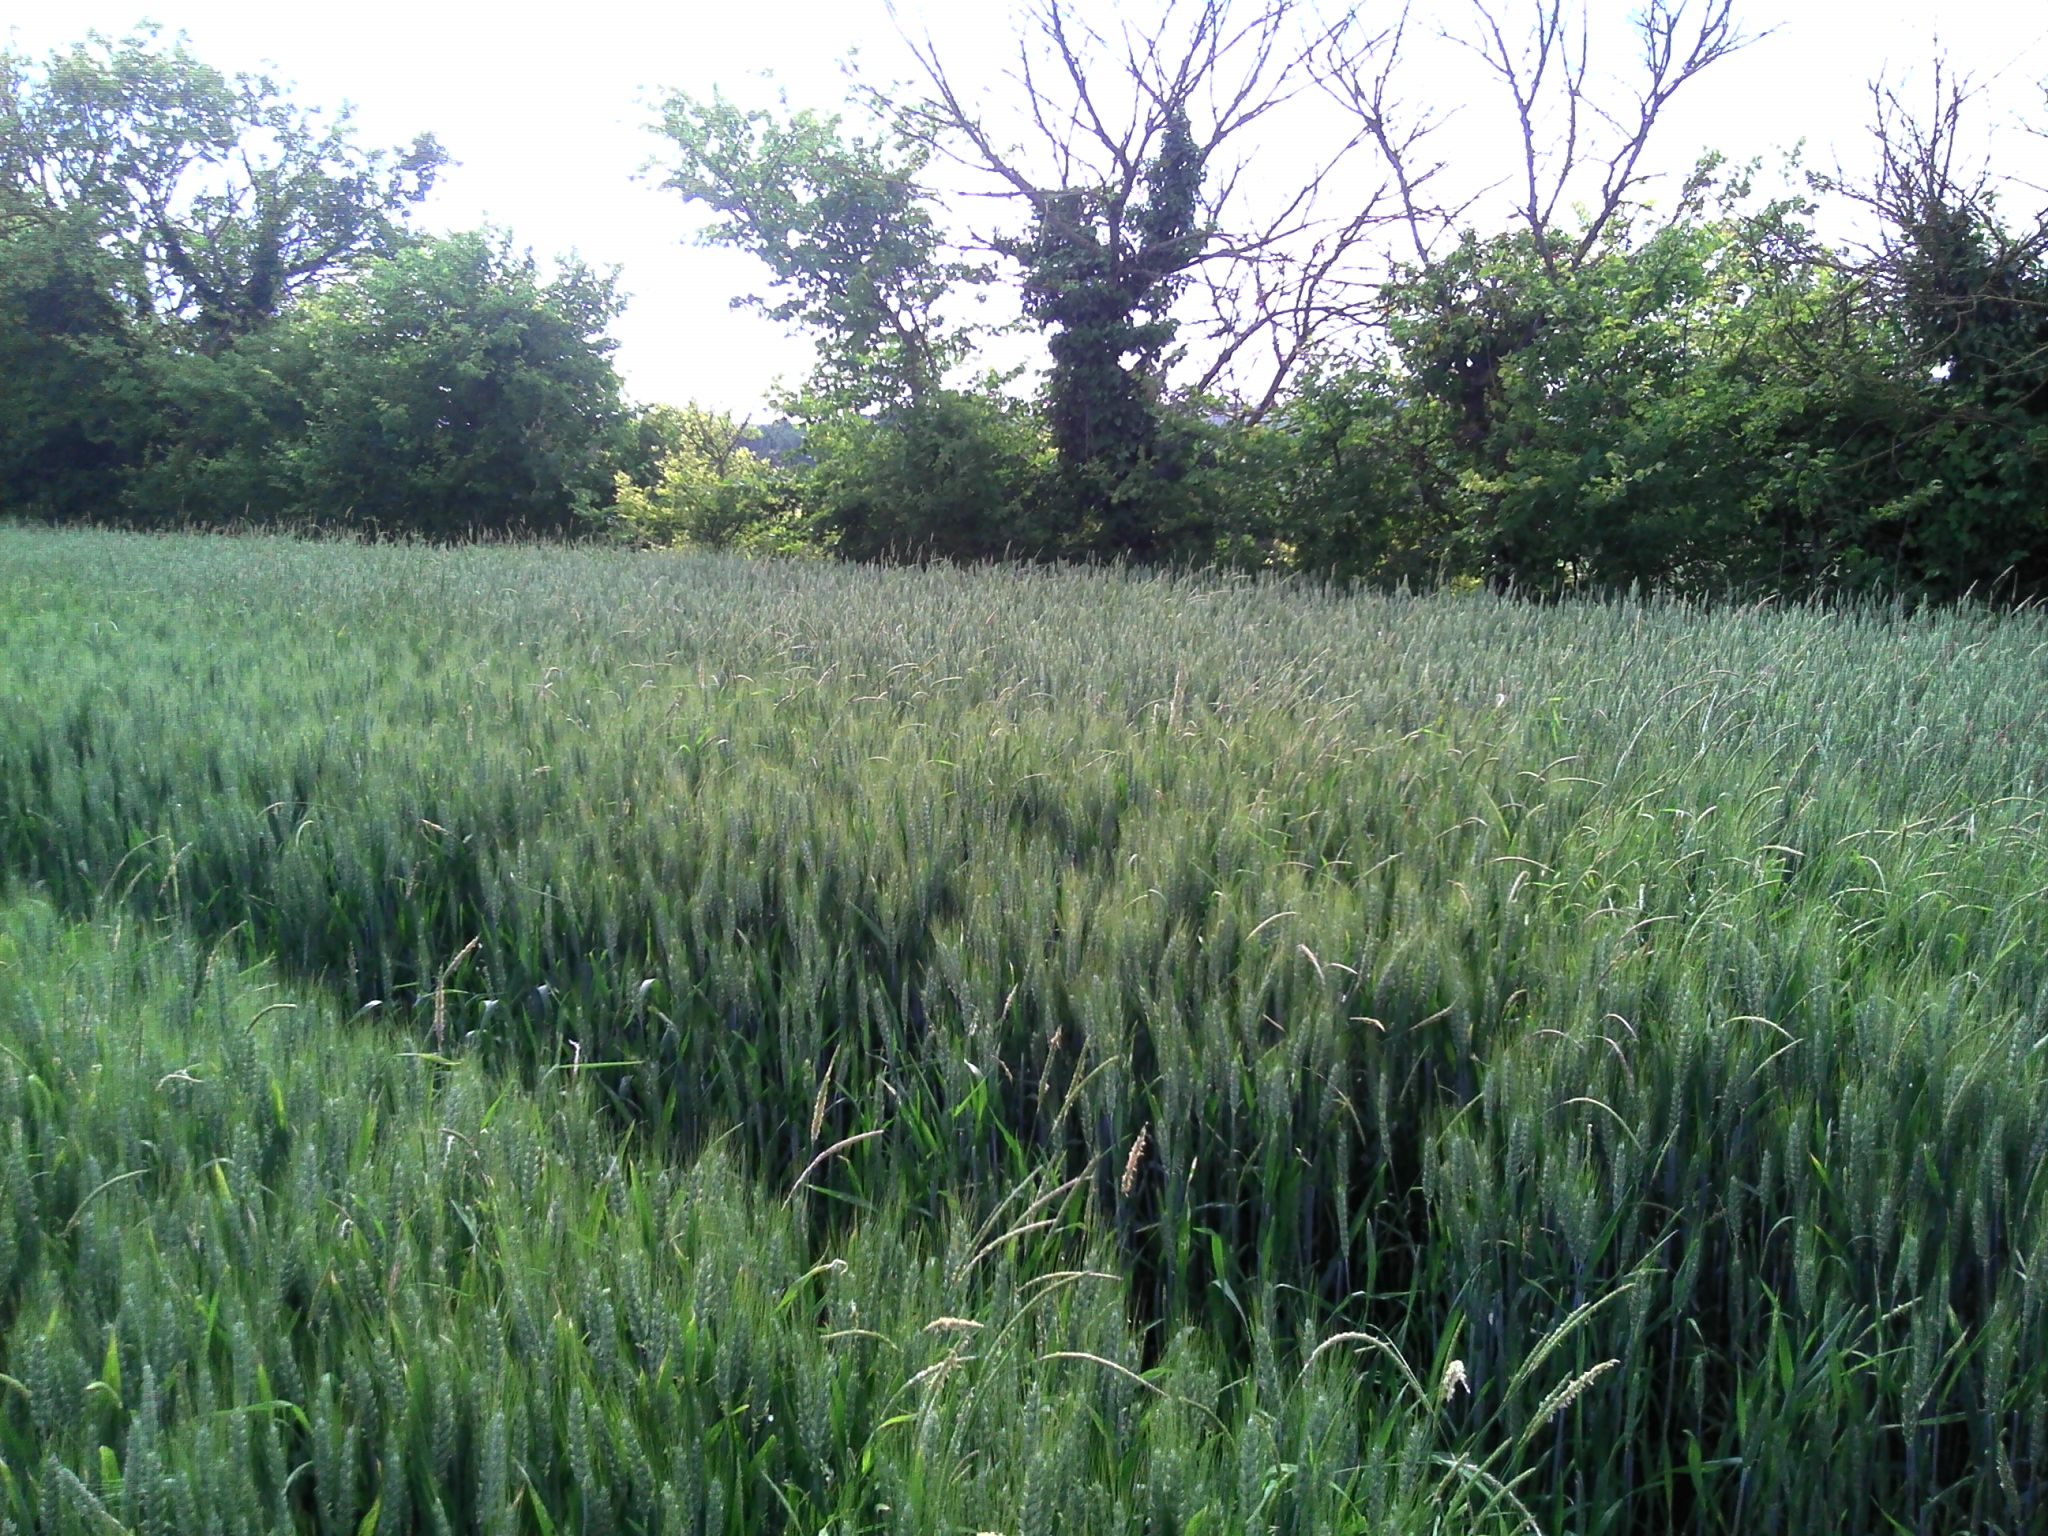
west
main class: Cropland
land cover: Common wheat
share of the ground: > 75 %
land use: Agriculture (excluding fallow land and kitchen gardens)
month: May
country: FR
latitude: 46.9140
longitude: 0.3817
